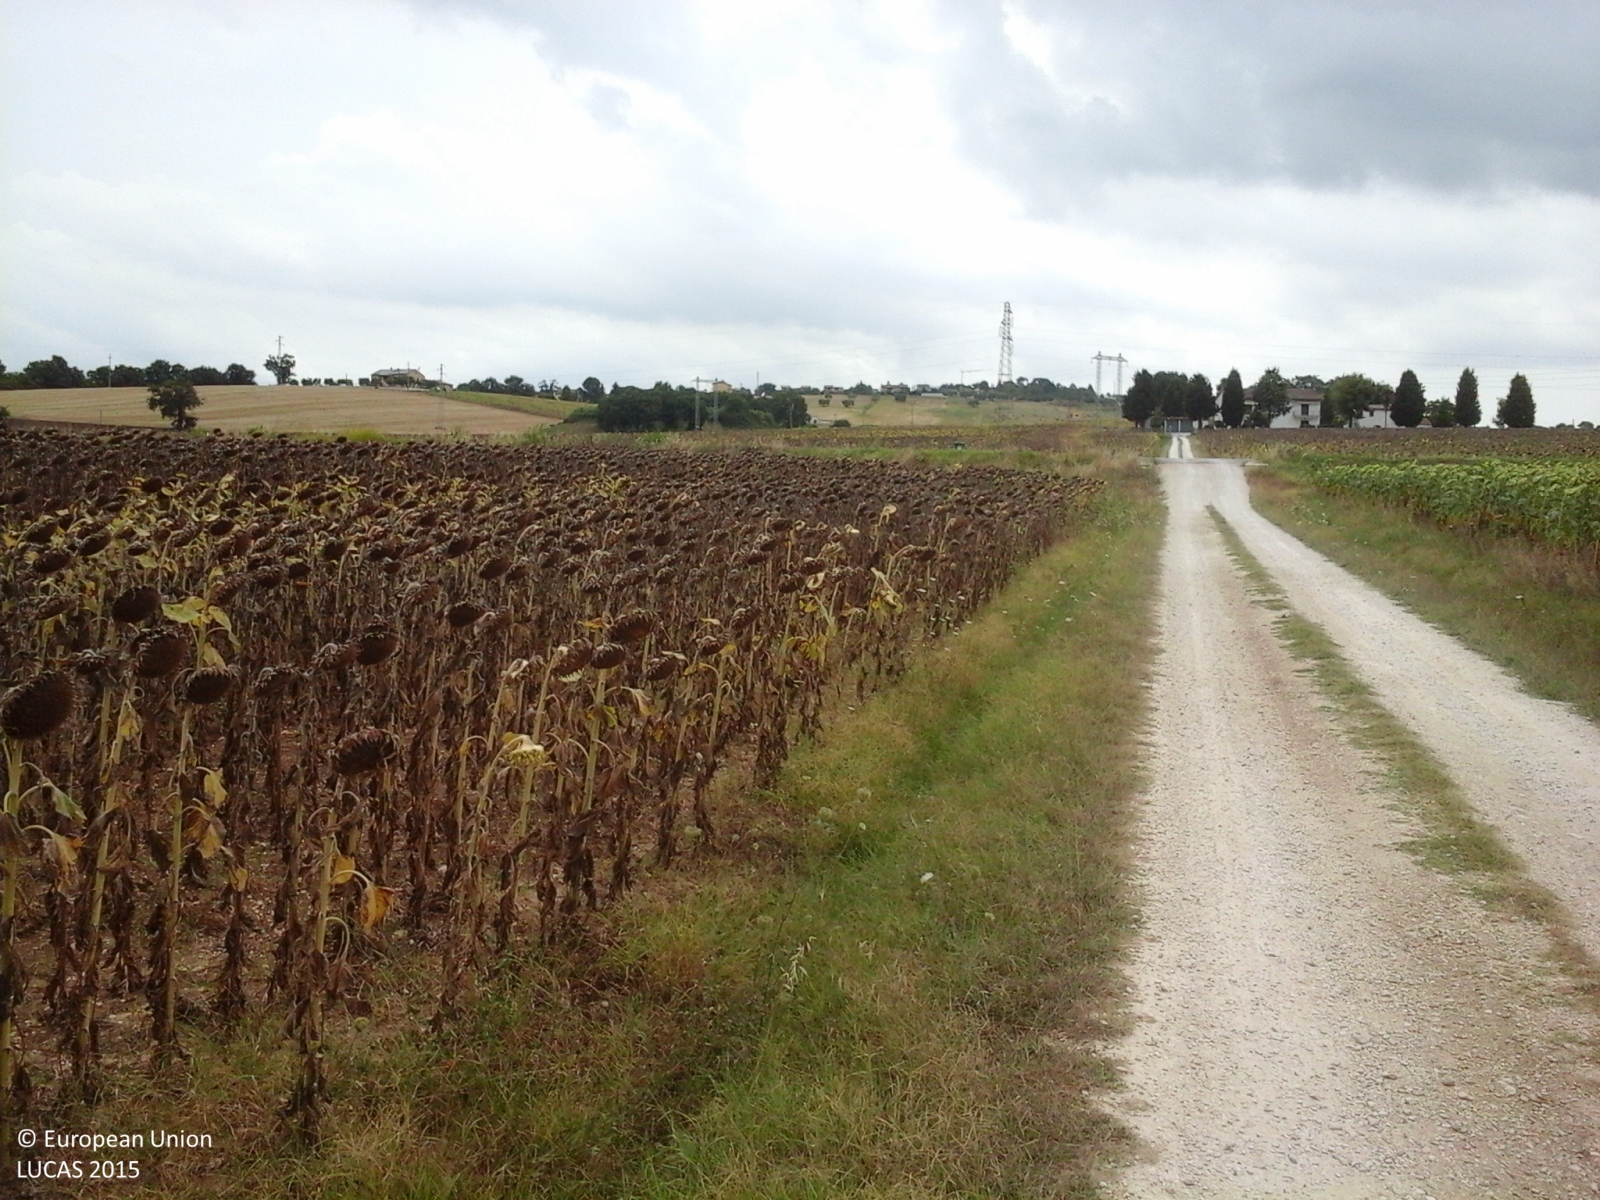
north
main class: Cropland
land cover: Sunflower
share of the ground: > 75 %
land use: Agriculture (excluding fallow land and kitchen gardens)
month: August
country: IT
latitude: 43.4604
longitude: 13.5138
